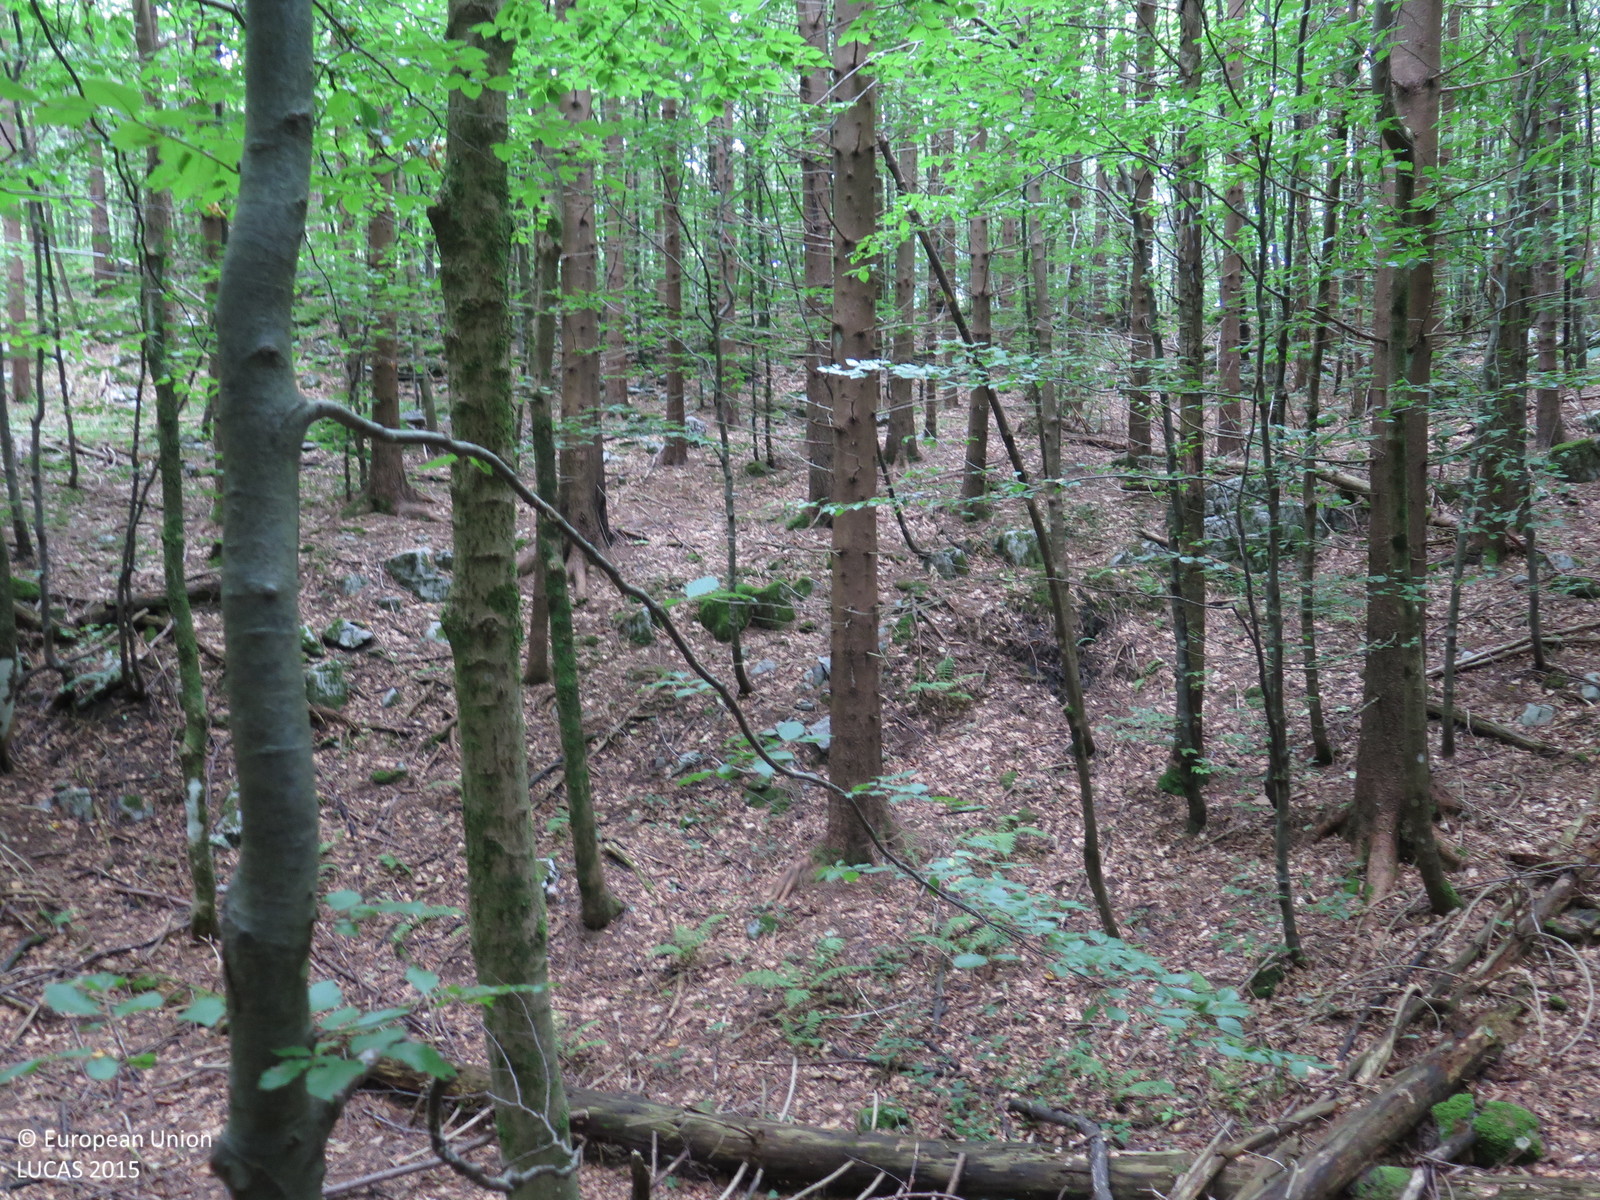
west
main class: Woodland
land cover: Other mixed woodland
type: mountainous beech forest
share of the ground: > 75 %
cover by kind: broadleaved forest trees 75 %, coniferous forest trees 25 %
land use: Forestry
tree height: > 5 m
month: August
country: HR
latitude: 45.1180
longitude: 14.9396
